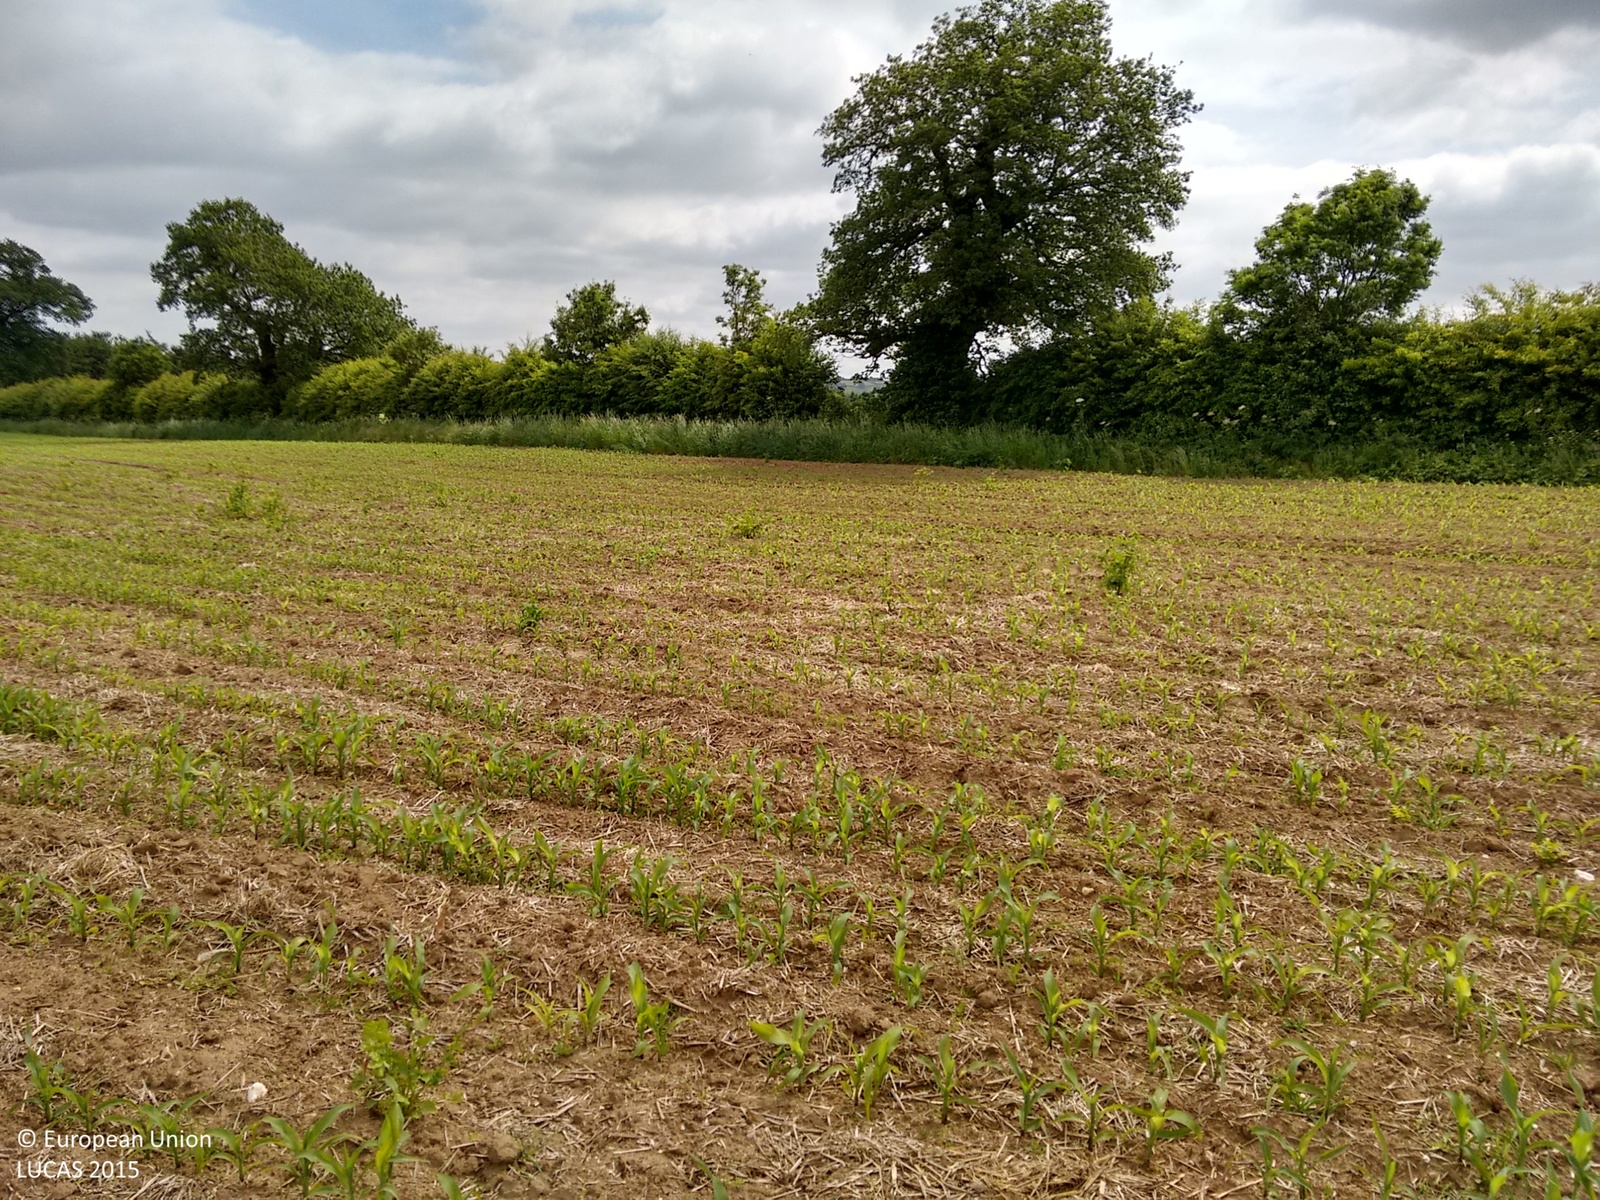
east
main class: Cropland
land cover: Maize
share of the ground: 50 - 75 %
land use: Agriculture (excluding fallow land and kitchen gardens)
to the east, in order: Maize; Grass margins; Managed hedges; Grassland without tree/shrub cover; Paved roads, cycling and walking lanes; Grassland without tree/shrub cover; Managed hedges; Grass margins; Common wheat
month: June
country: GB
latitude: 53.2869
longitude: -0.0982
